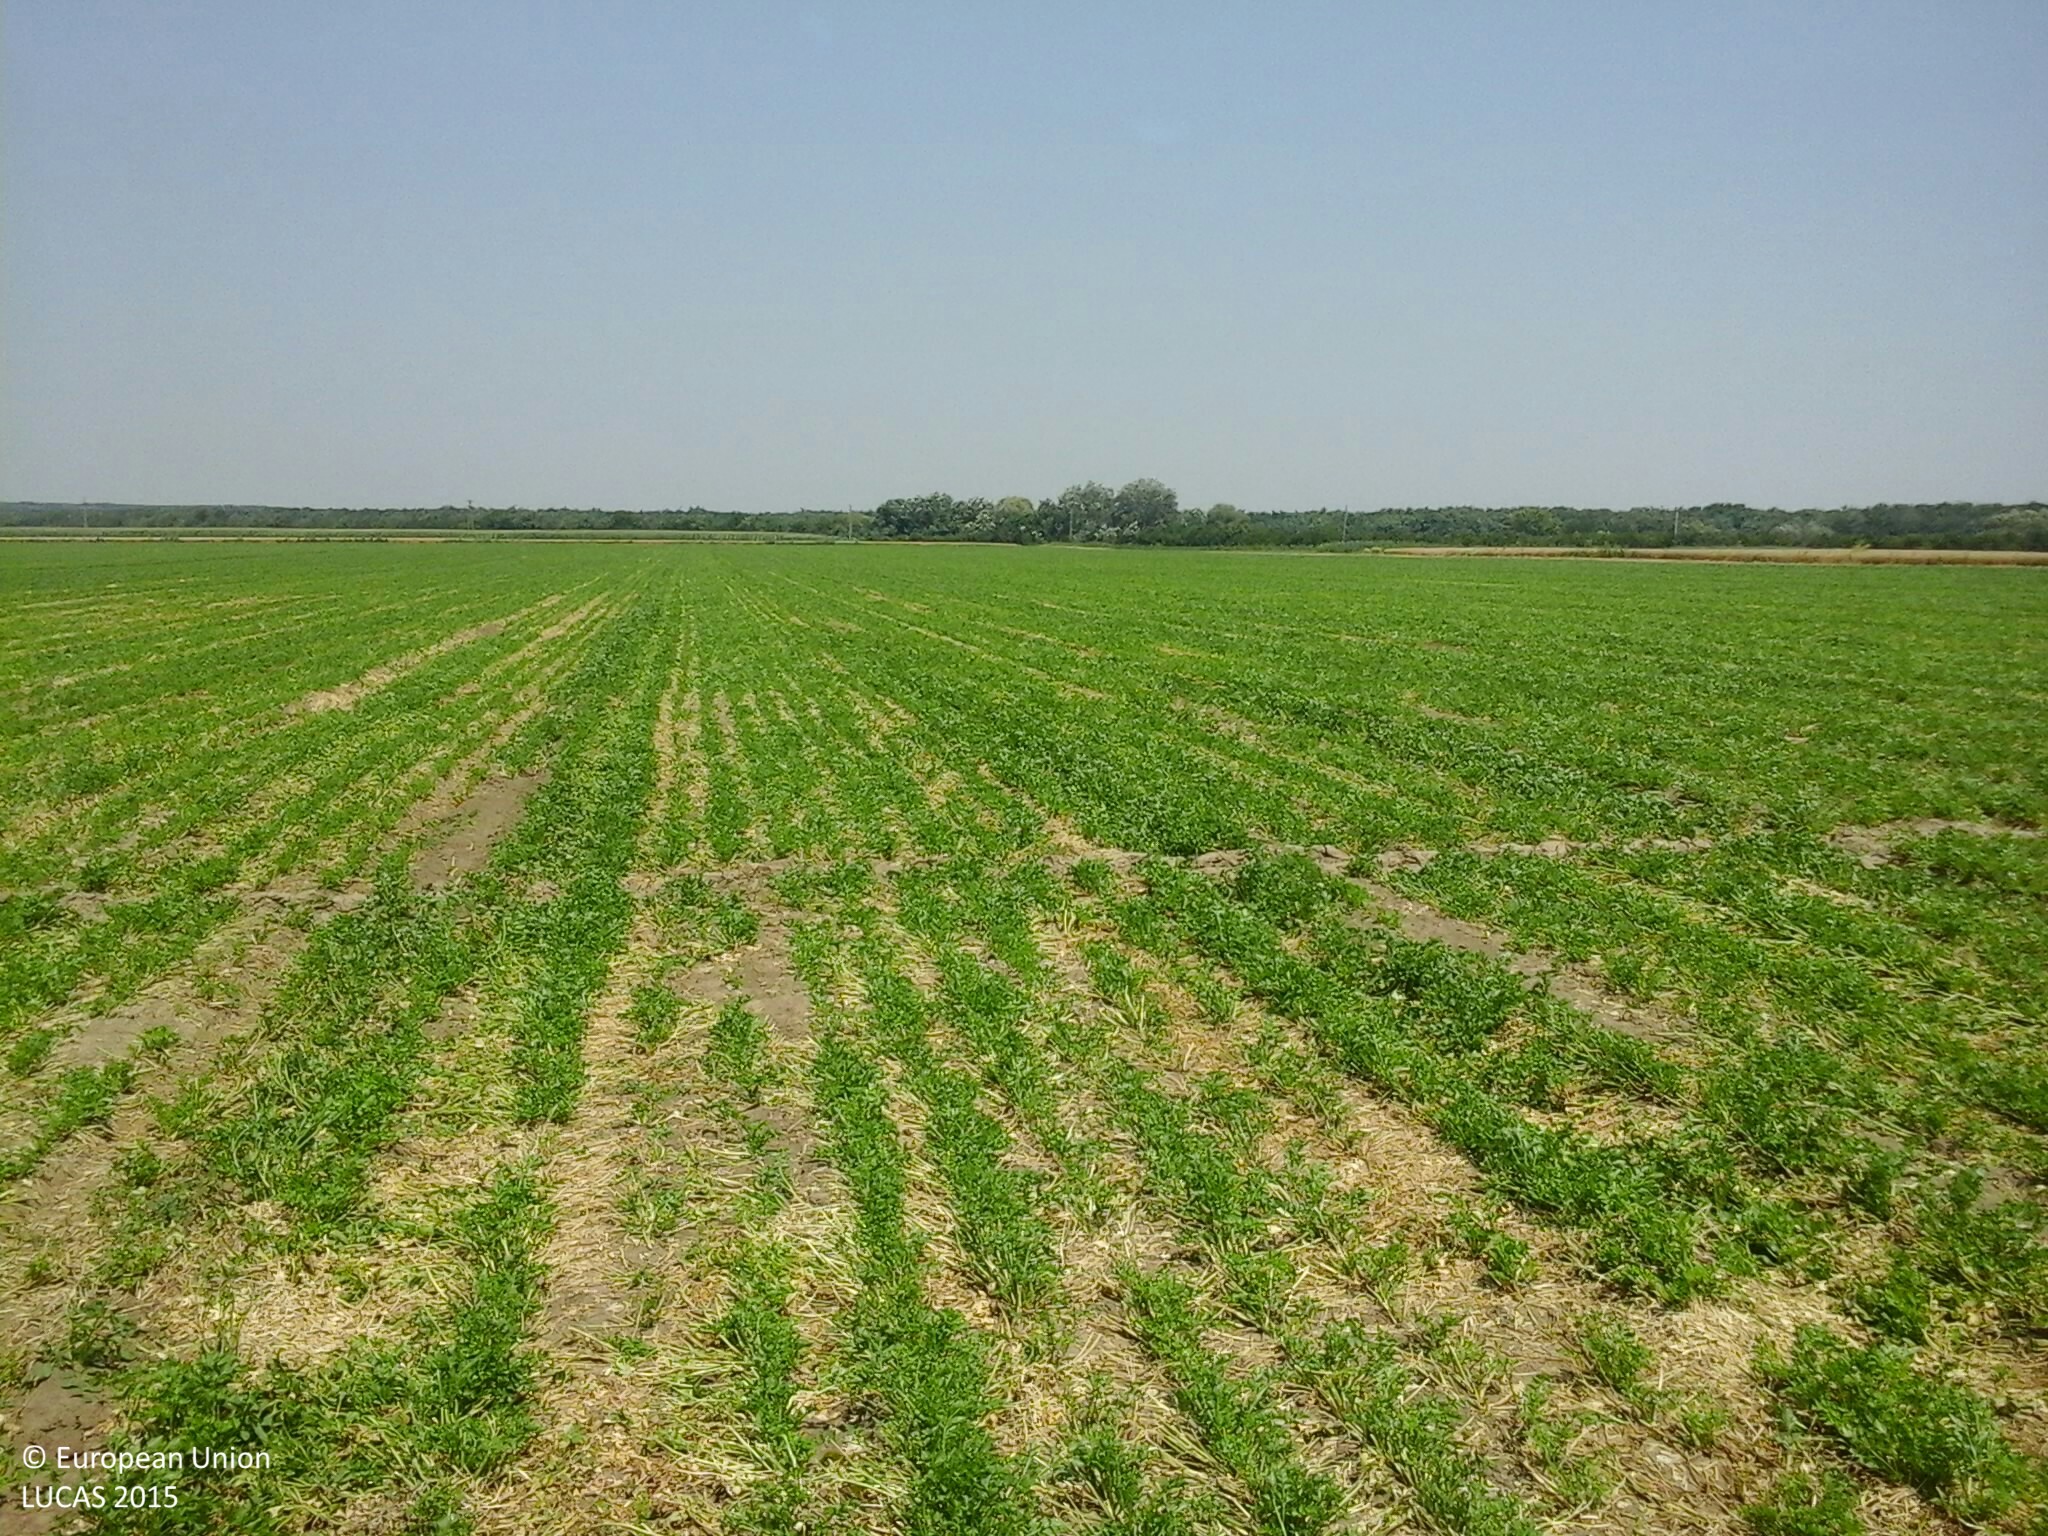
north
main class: Cropland
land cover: Other non-permanent industrial crops
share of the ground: 50 - 75 %
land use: Agriculture (excluding fallow land and kitchen gardens)
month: July
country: HU
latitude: 46.9706
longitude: 20.1858
